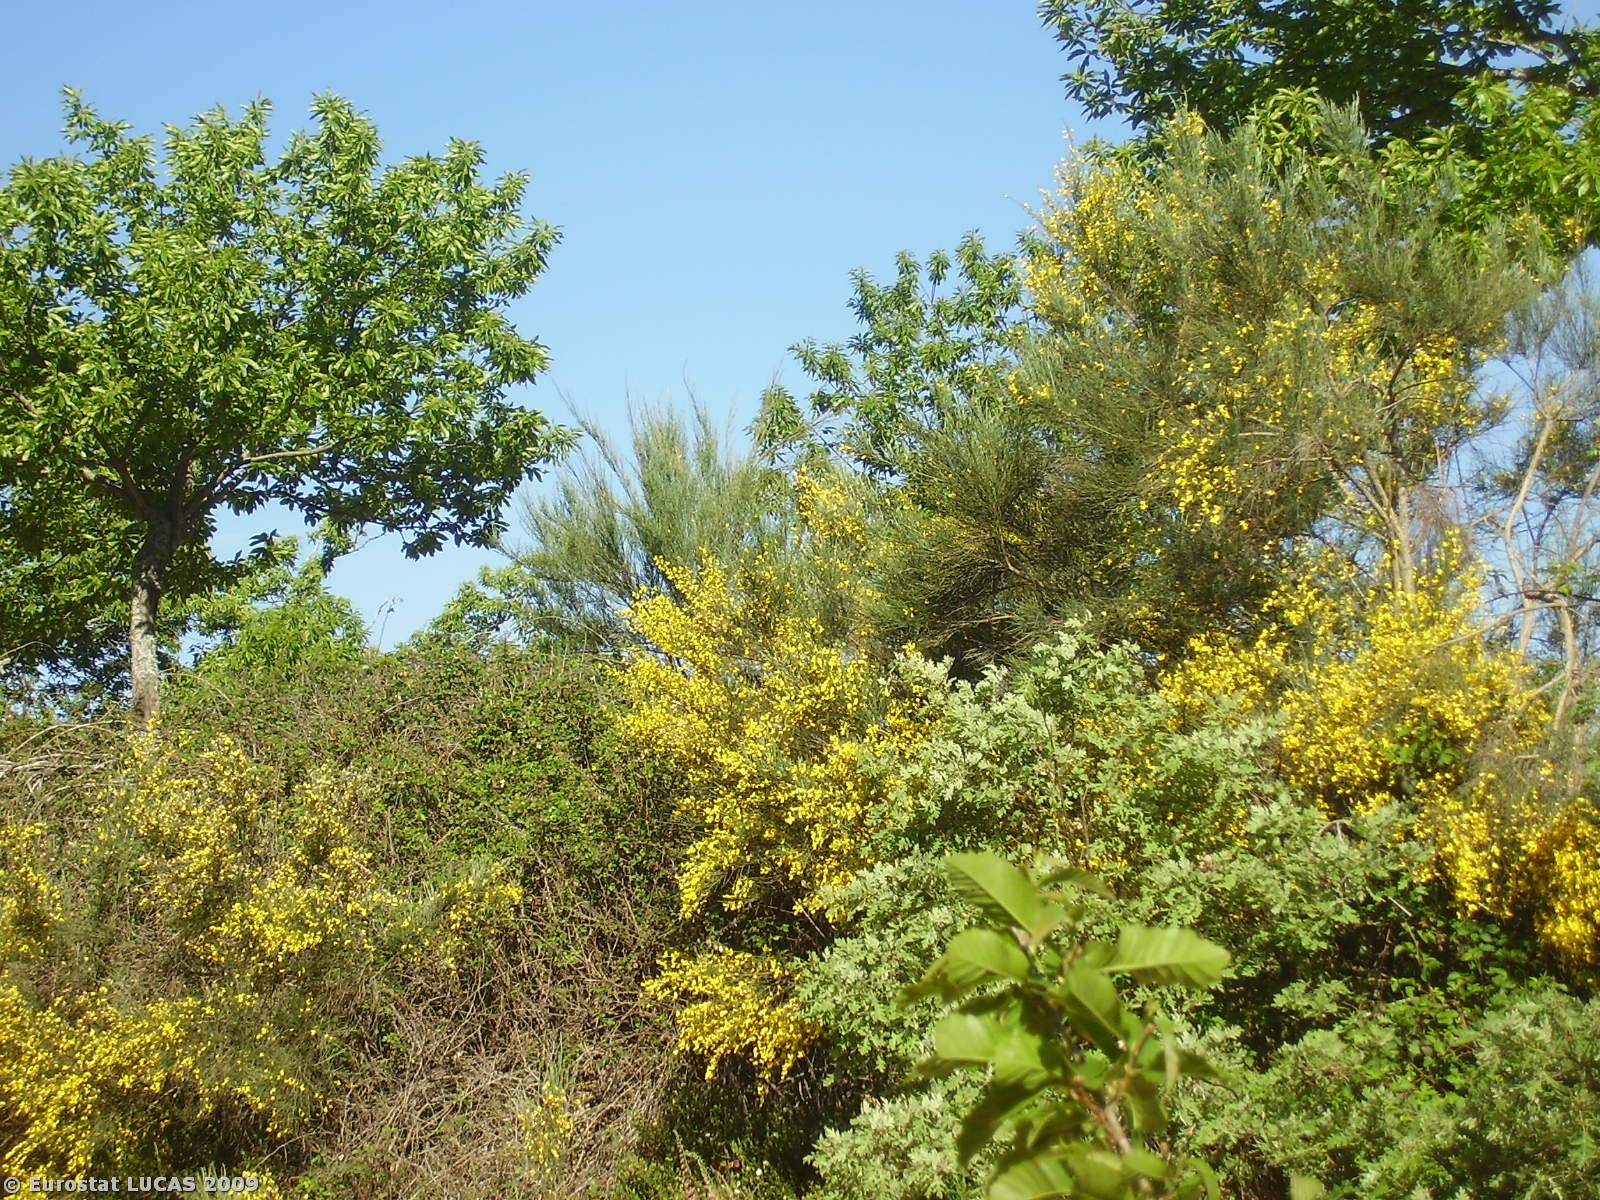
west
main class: Cropland
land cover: Other fruit trees and berries
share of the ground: 10 - 25 %
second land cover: Spontaneously vegetated surfaces
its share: < 10 %
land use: Agriculture (excluding fallow land and kitchen gardens)
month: June
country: PT
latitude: 41.7528
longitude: -6.9171
